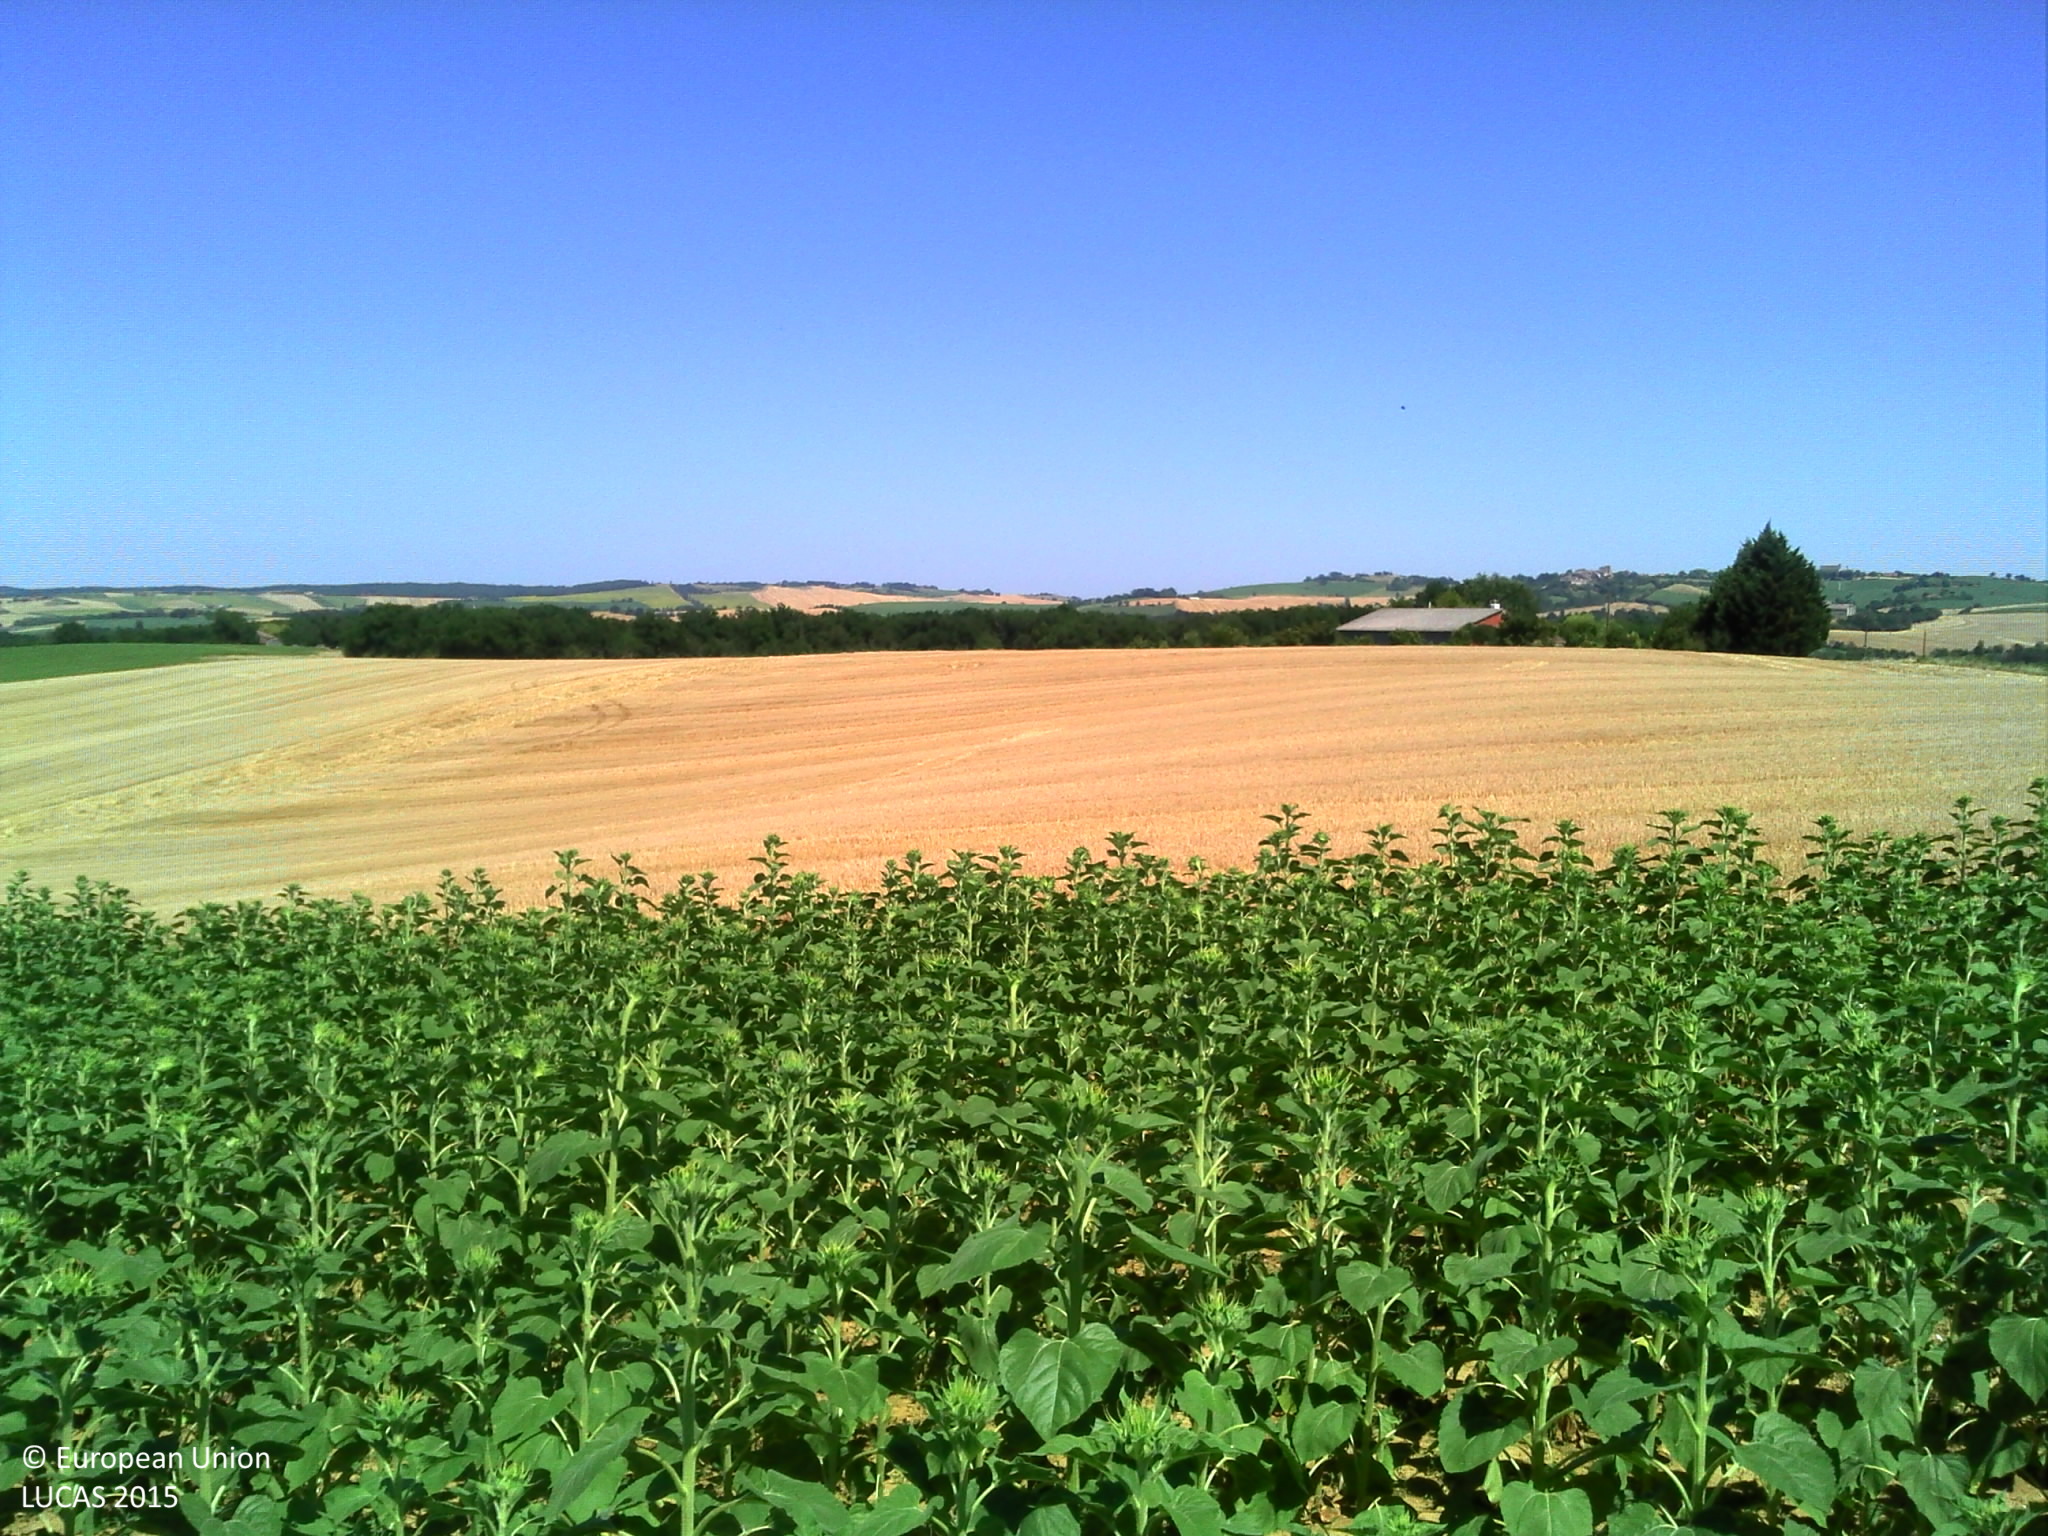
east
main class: Cropland
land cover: Sunflower
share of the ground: > 75 %
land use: Agriculture (excluding fallow land and kitchen gardens)
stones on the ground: < 10 %
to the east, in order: Sunflower; Common wheat; Grass margins; Vineyards; Other fruit trees and berries; Common wheat
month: July
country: FR
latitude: 44.0051
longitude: 0.7047
